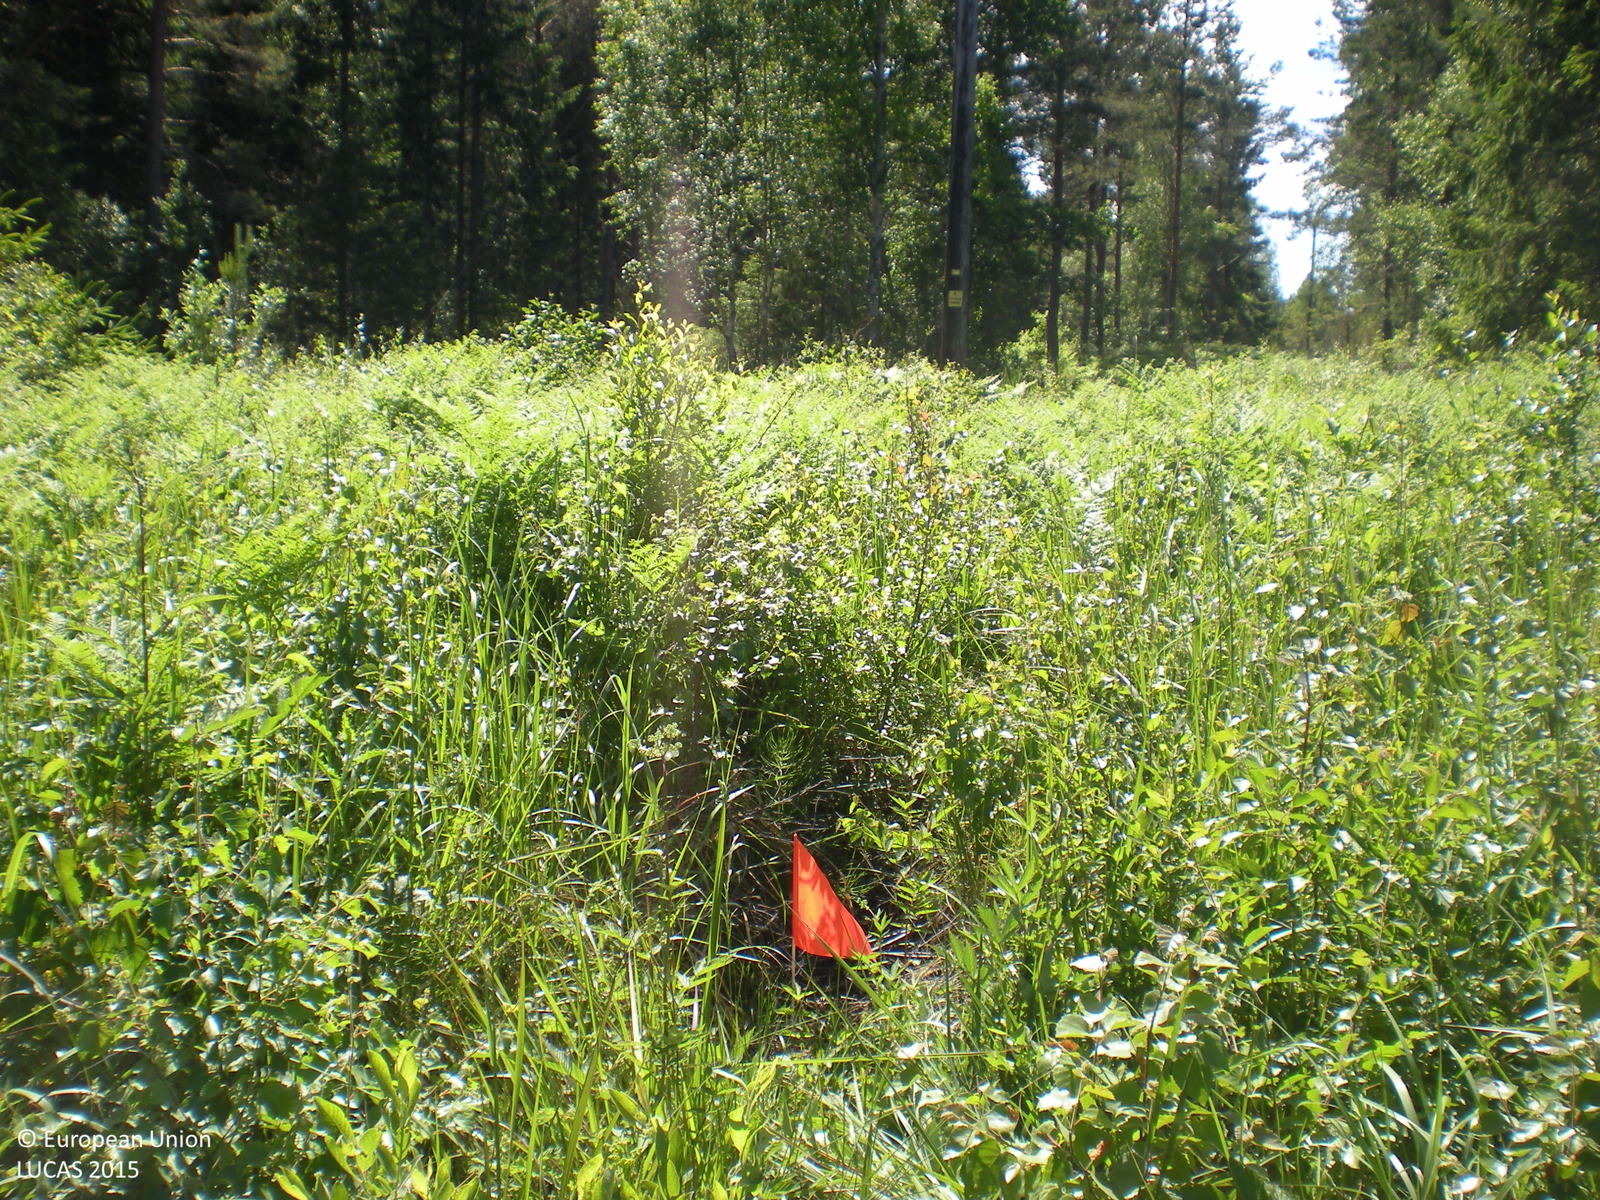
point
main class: Grassland
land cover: Grassland with sparse tree/shrub cover
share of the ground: > 75 %
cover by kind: herbaceous plants 85 %, shrubs 10 %, broadleaved forest trees 5 %
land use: Electricity, gas and thermal power distribution
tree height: < 5 m
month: July
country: SE
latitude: 60.5909
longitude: 17.9336
